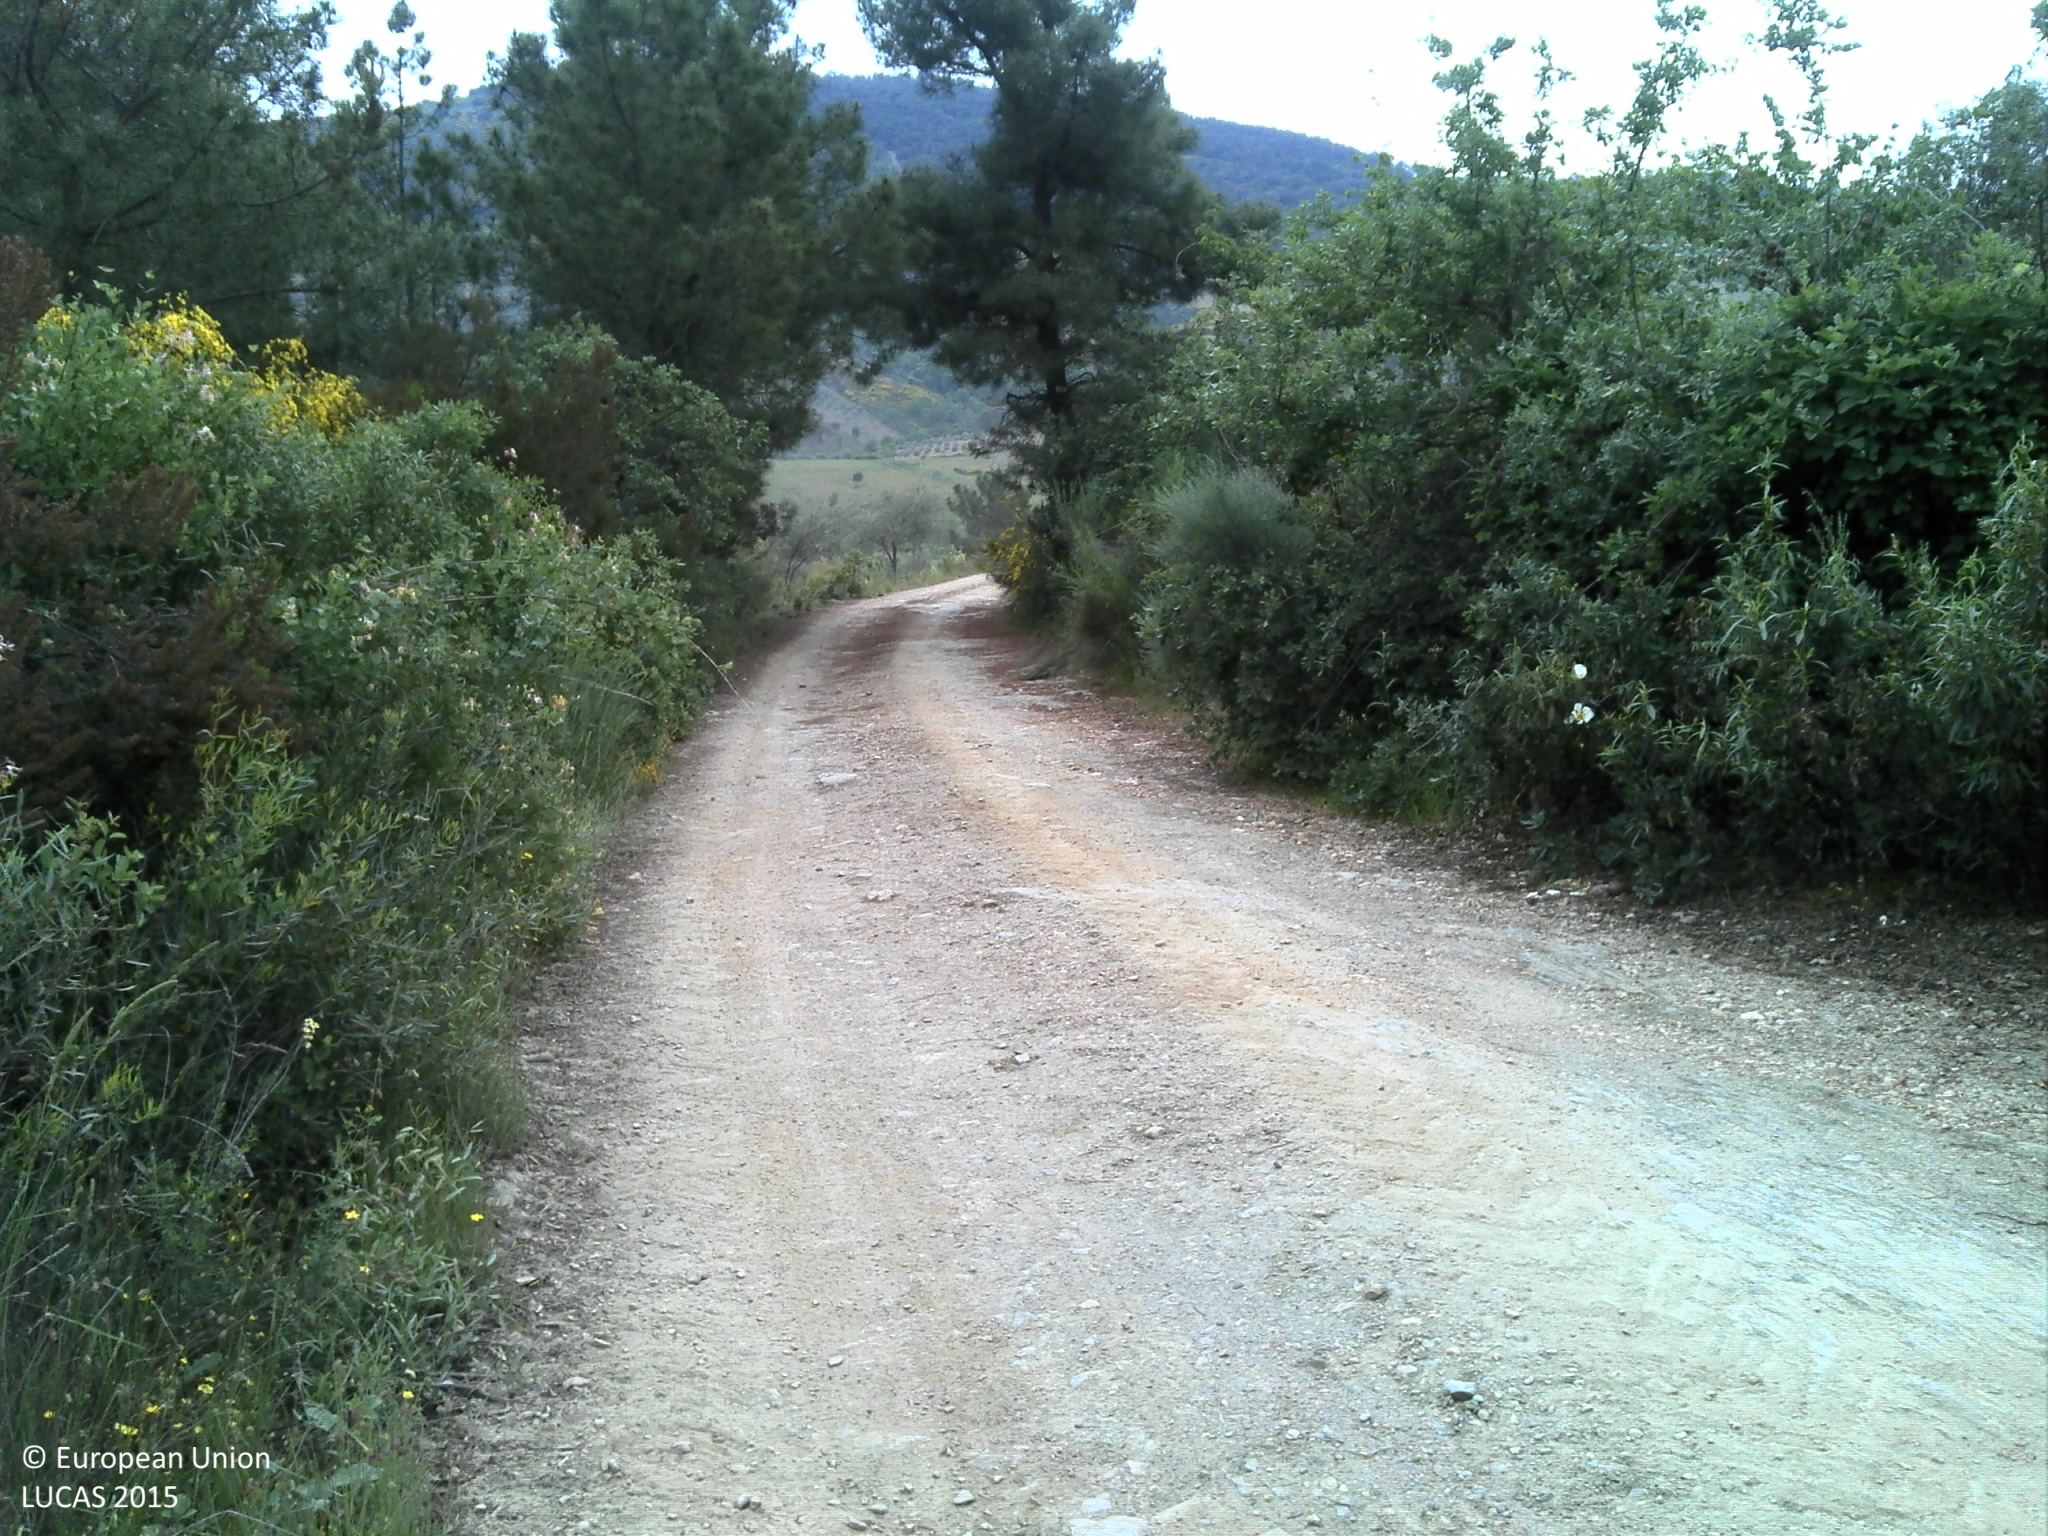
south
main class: Shrubland
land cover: Shrubland with sparse tree cover
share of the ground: > 75 %
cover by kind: shrubs 80 %, herbaceous plants 10 %, broadleaved forest trees 5 %, unconsolidated bare surface 5 %
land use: Abandoned areas
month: May
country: PT
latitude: 41.6448
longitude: -7.0098
